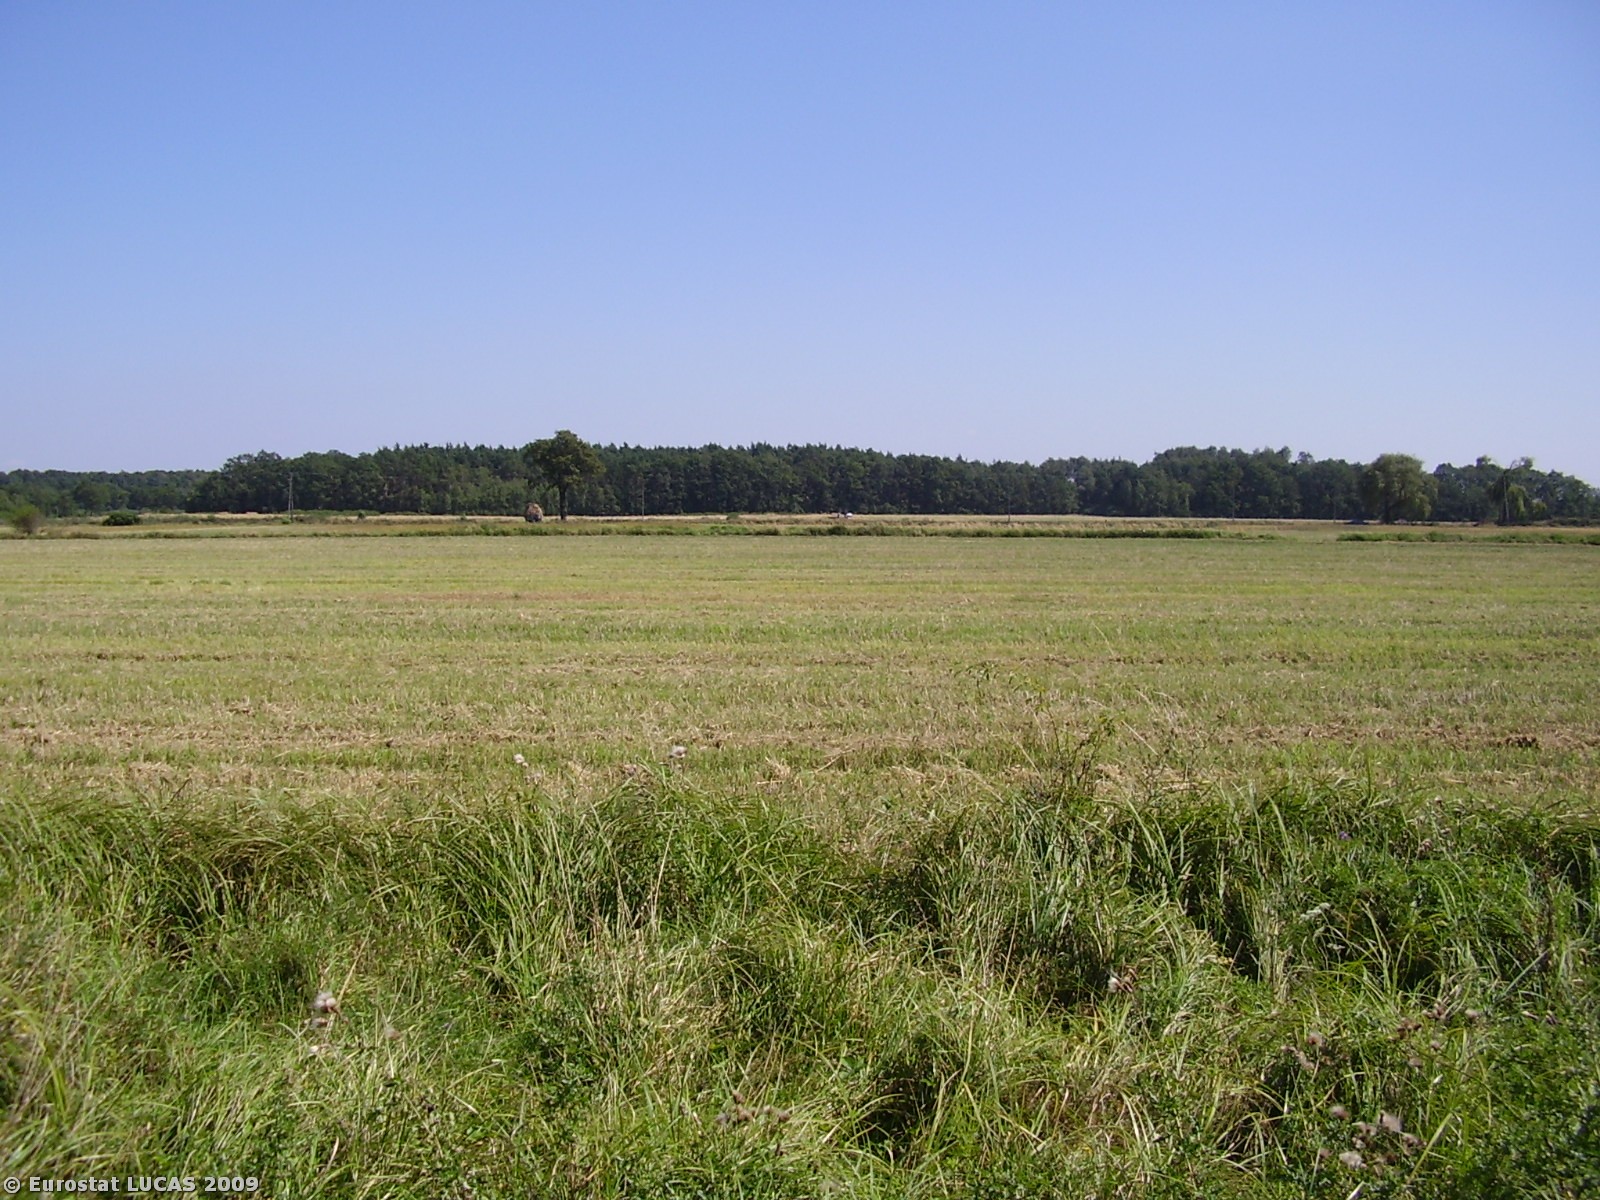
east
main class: Grassland
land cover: Grassland without tree/shrub cover
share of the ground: > 75 %
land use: Unused
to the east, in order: Grassland without tree/shrub cover; Triticale; Ditches and canals; Triticale
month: August
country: PL
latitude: 51.2817
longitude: 16.1282
